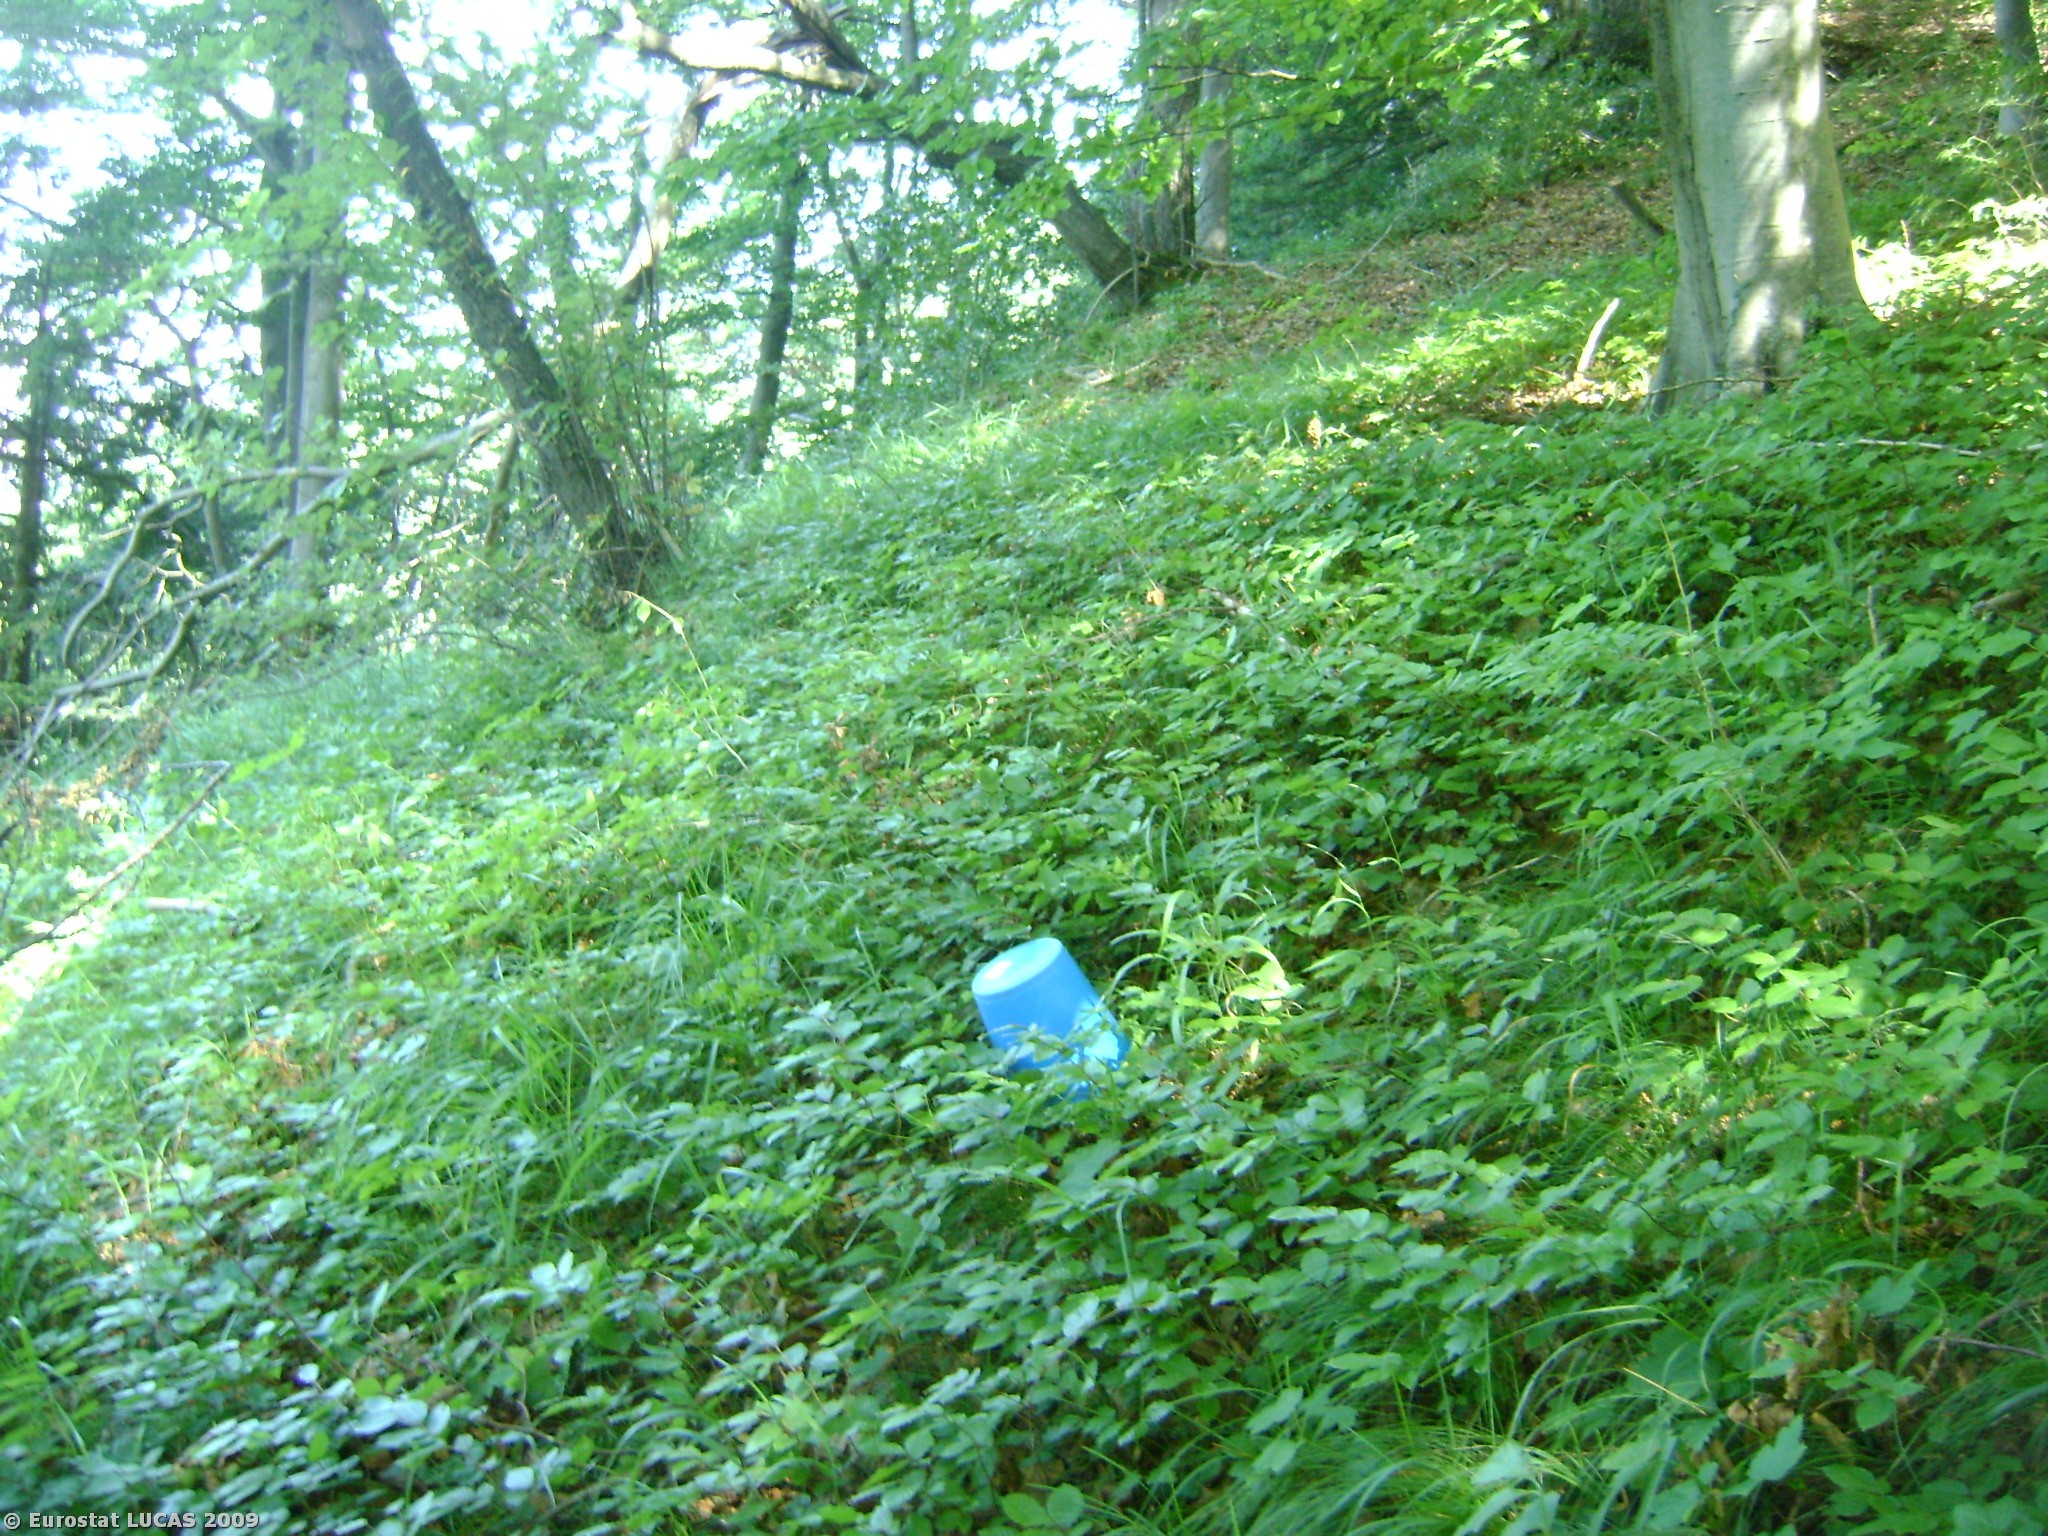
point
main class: Woodland
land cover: Broadleaved woodland
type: beech forest
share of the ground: > 75 %
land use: Forestry
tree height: > 5 m
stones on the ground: < 10 %
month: July
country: AT
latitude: 47.3411
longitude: 9.6694
